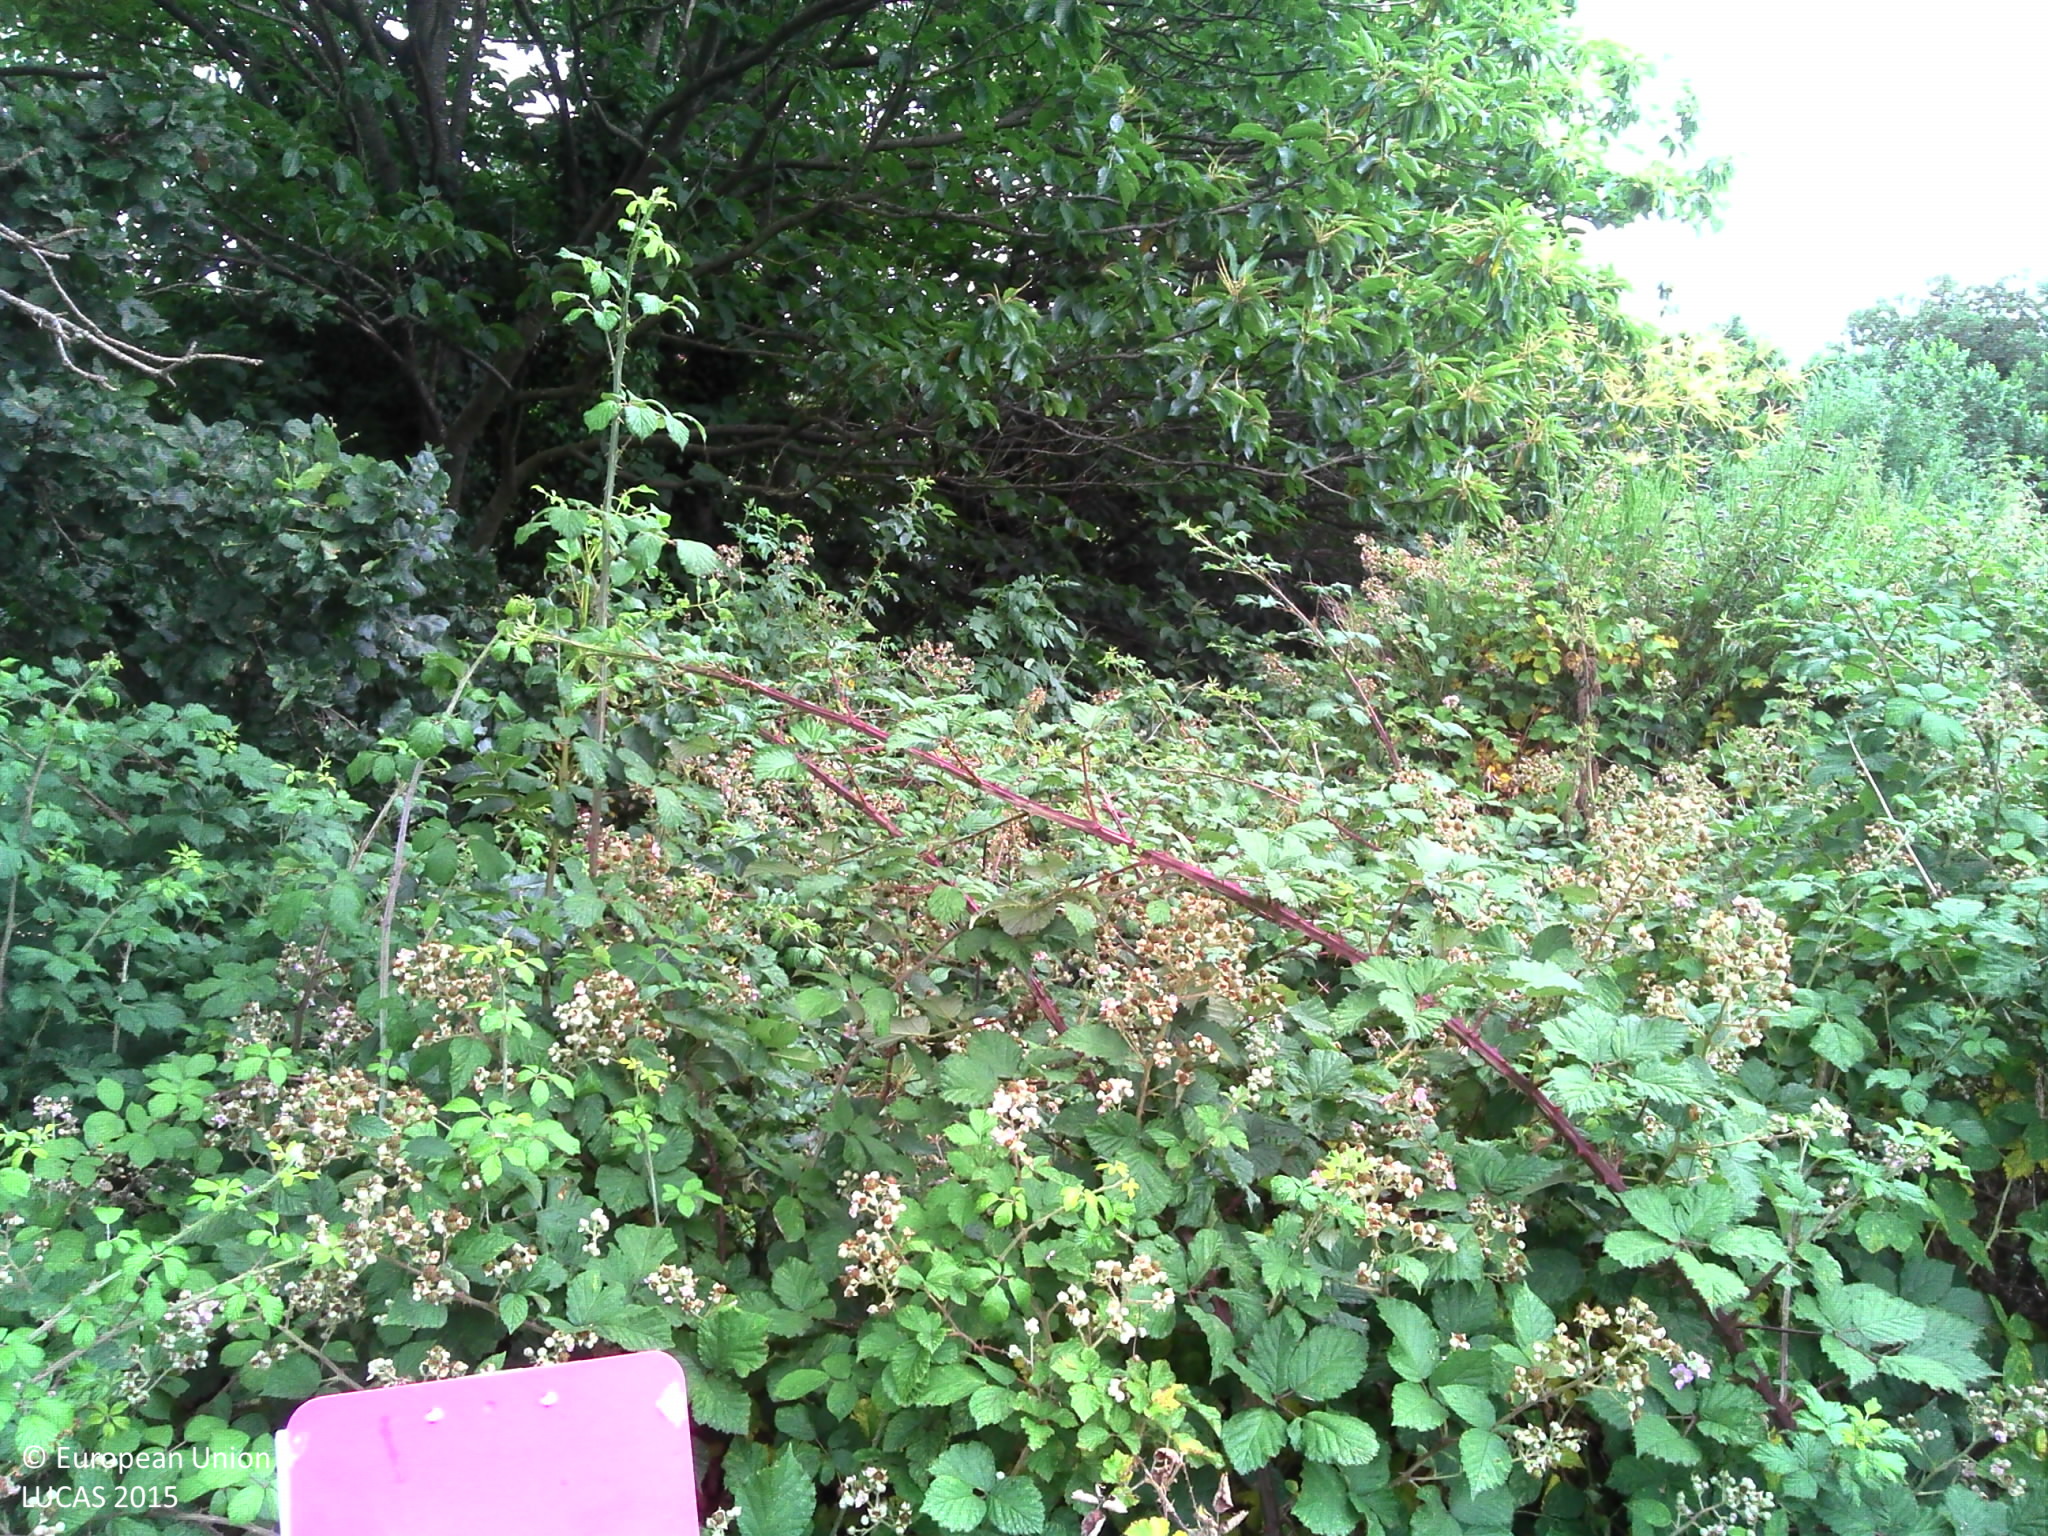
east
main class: Woodland
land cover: Broadleaved woodland
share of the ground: > 75 %
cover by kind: herbaceous plants 50 %, shrubs 35 %, broadleaved forest trees 15 %
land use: Semi-natural and natural areas not in use
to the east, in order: Broadleaved woodland; Grassland without tree/shrub cover; Tracks; Grassland without tree/shrub cover; Artificial constructions in urban areas; Grassland without tree/shrub cover
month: July
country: FR
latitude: 47.8343
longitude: -1.3585
